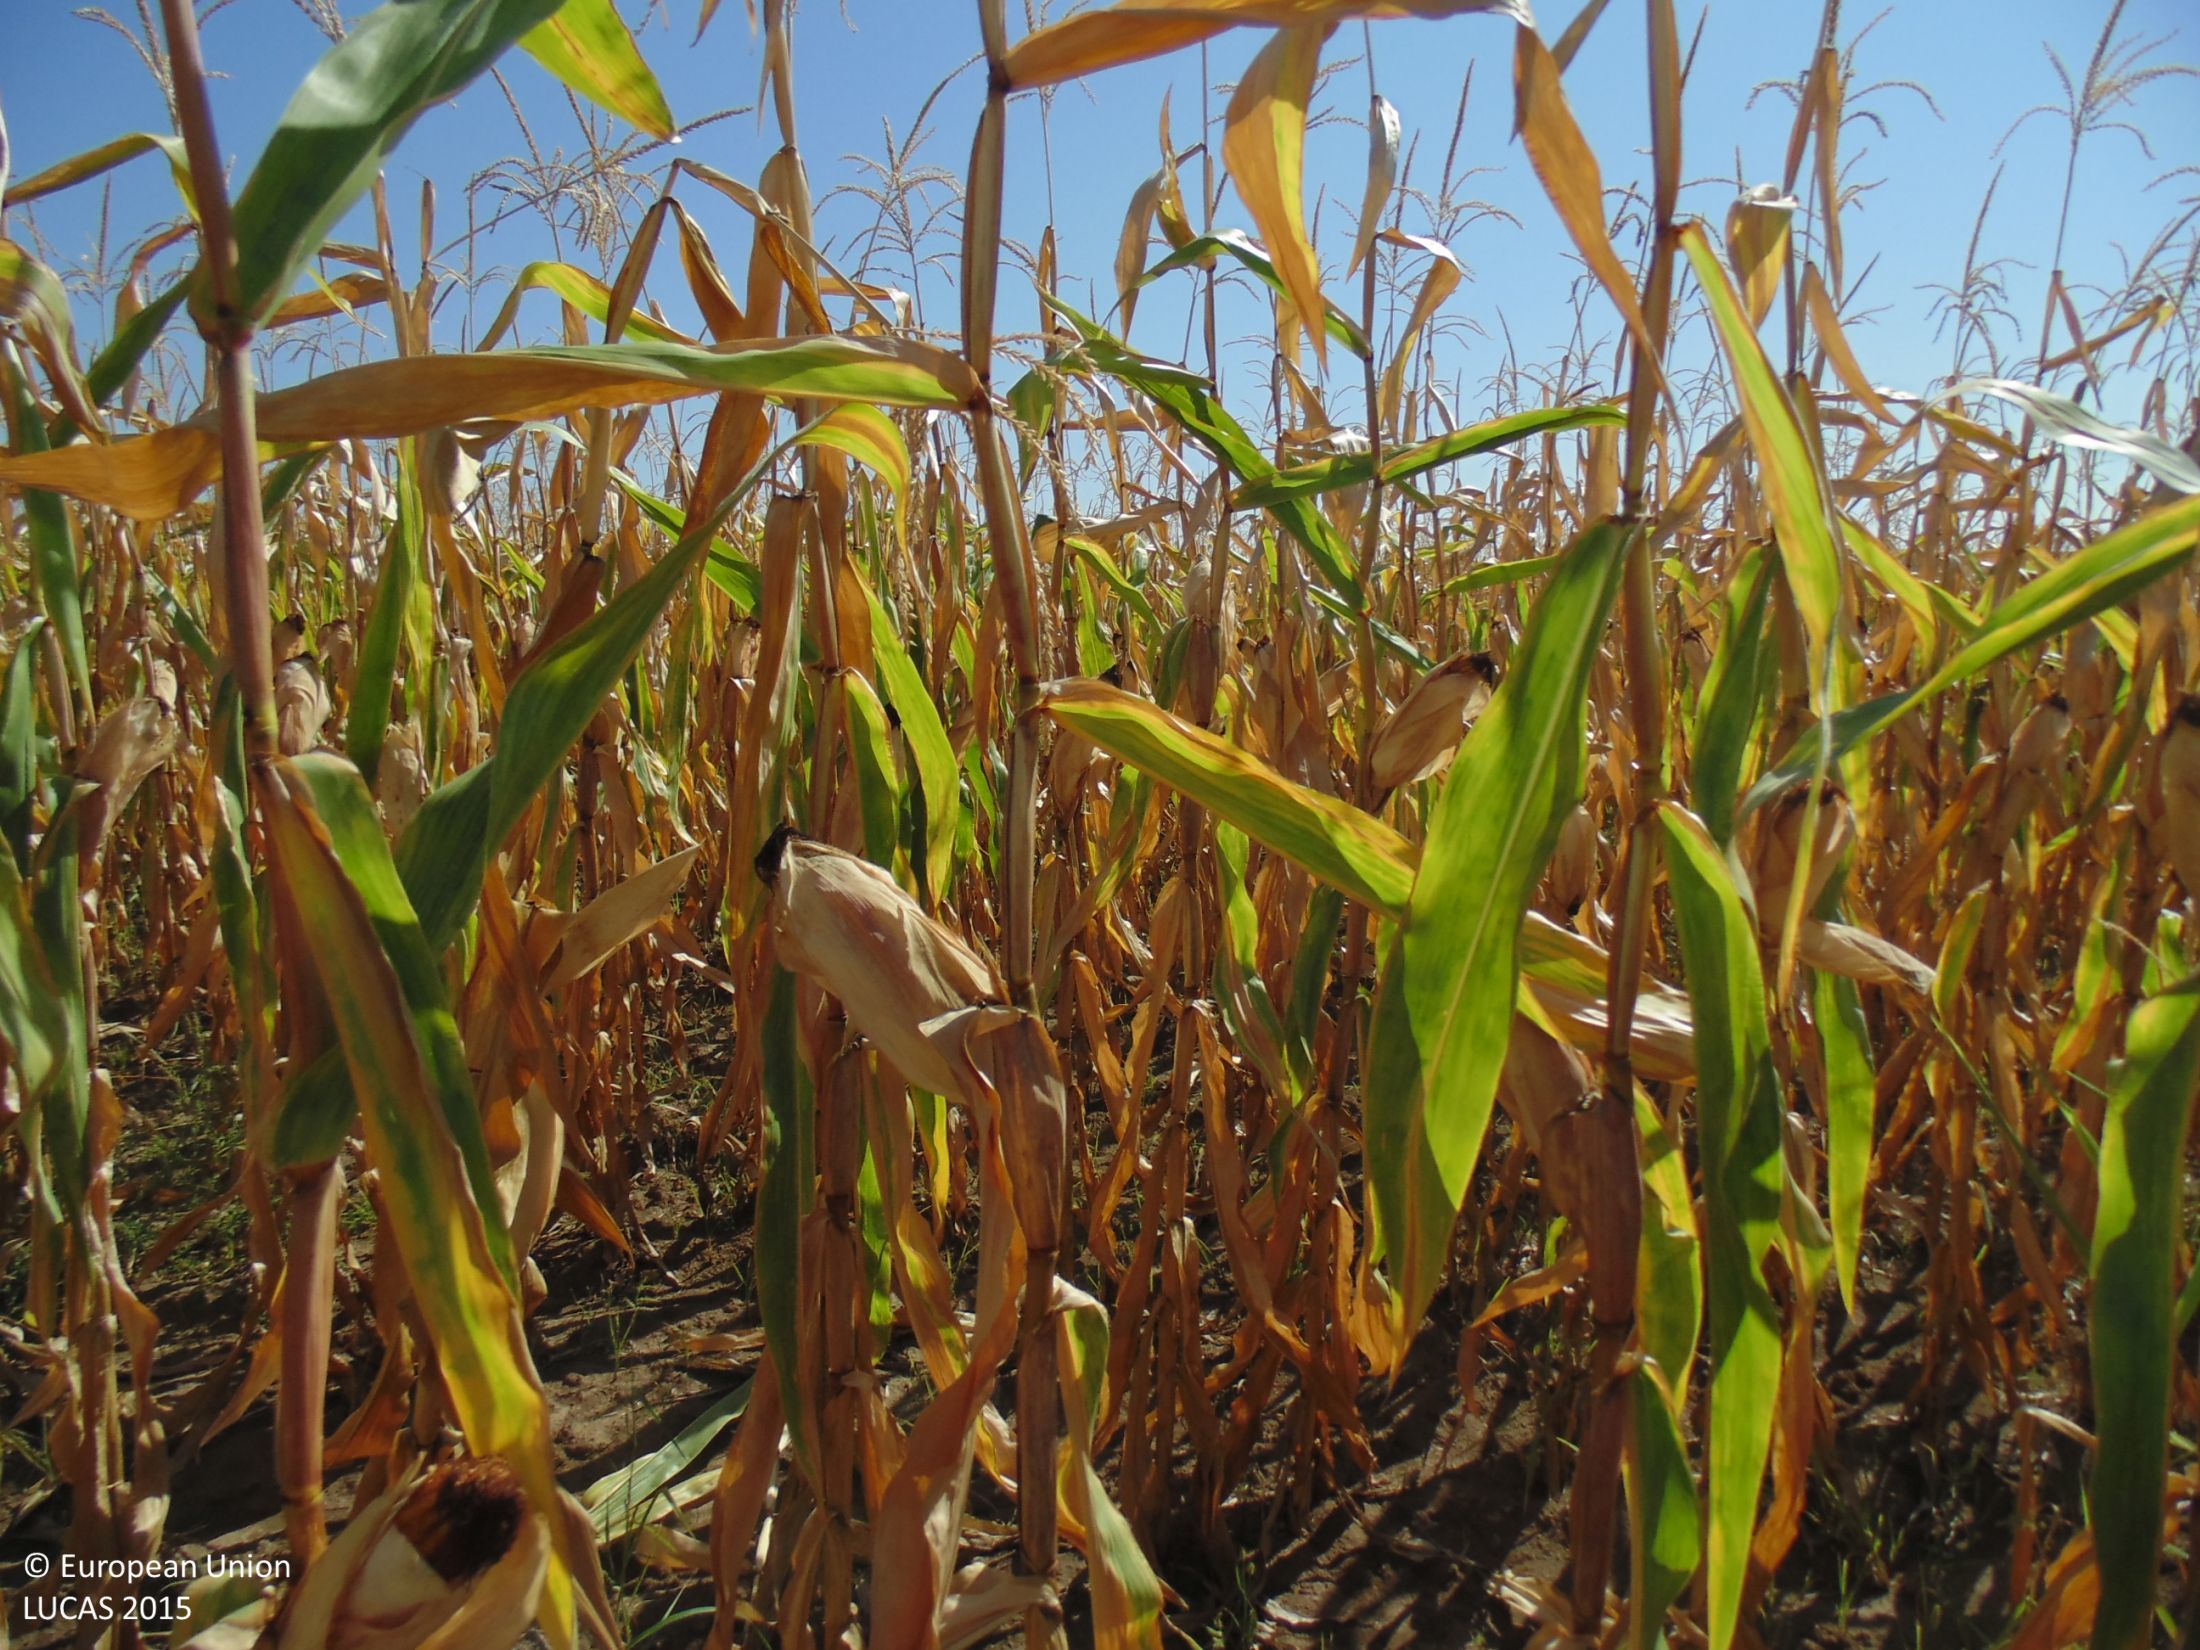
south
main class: Cropland
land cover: Maize
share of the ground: > 75 %
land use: Agriculture (excluding fallow land and kitchen gardens)
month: September
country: BG
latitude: 43.8938
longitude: 26.9898
